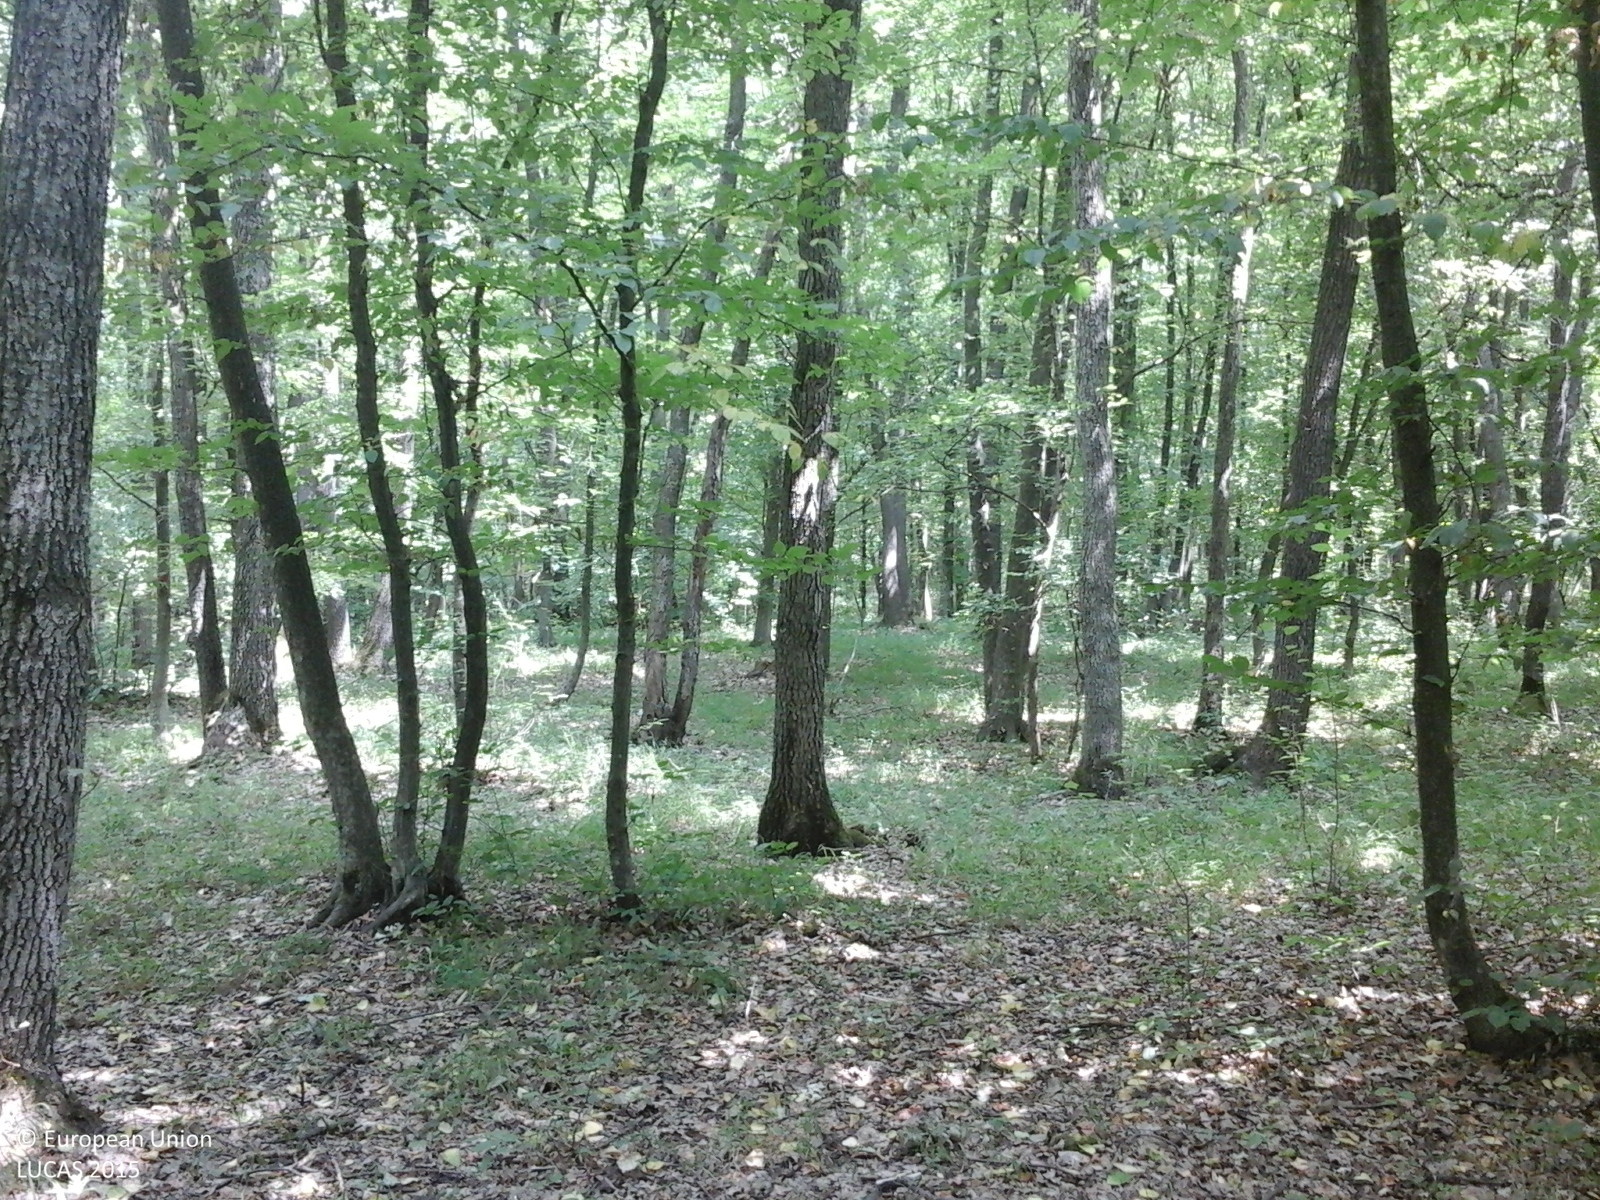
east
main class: Woodland
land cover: Broadleaved woodland
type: mesophytic deciduous forest
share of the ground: > 75 %
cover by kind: broadleaved forest trees 100 %
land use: Forestry
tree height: > 5 m
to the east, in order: Broadleaved woodland; Ditches and canals; Broadleaved woodland
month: June
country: RO
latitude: 47.7700
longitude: 26.5445
